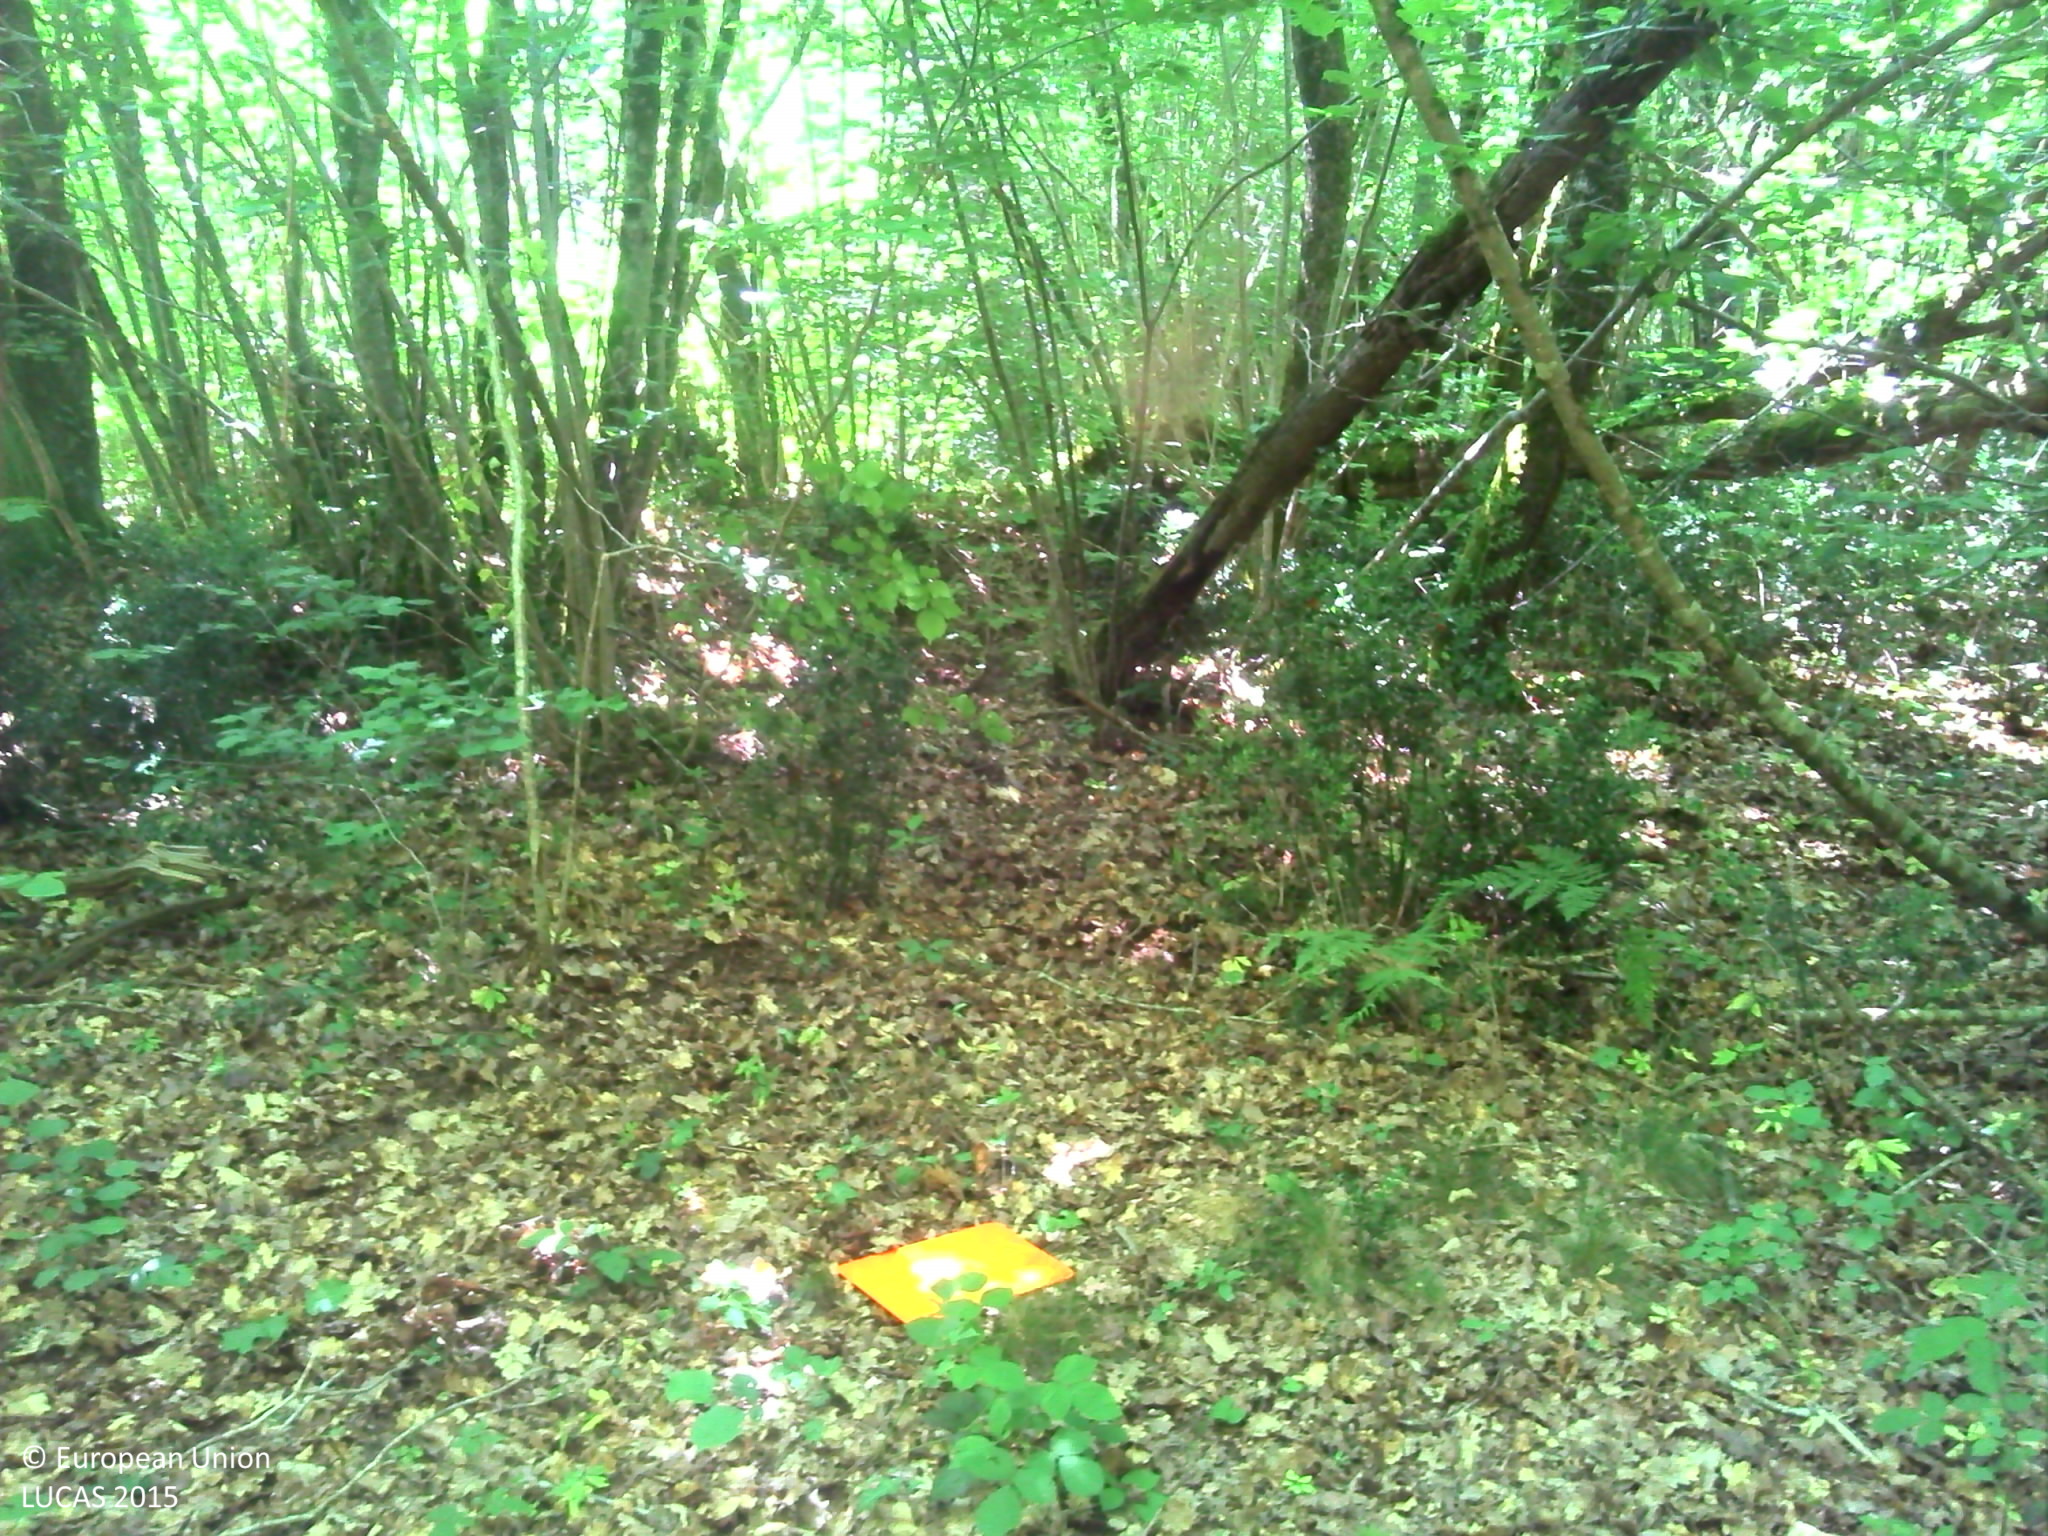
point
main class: Woodland
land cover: Broadleaved woodland
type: mesophytic deciduous forest
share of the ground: > 75 %
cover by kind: broadleaved forest trees 100 %
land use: Forestry
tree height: > 5 m
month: June
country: FR
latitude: 45.6558
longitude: -0.6367
